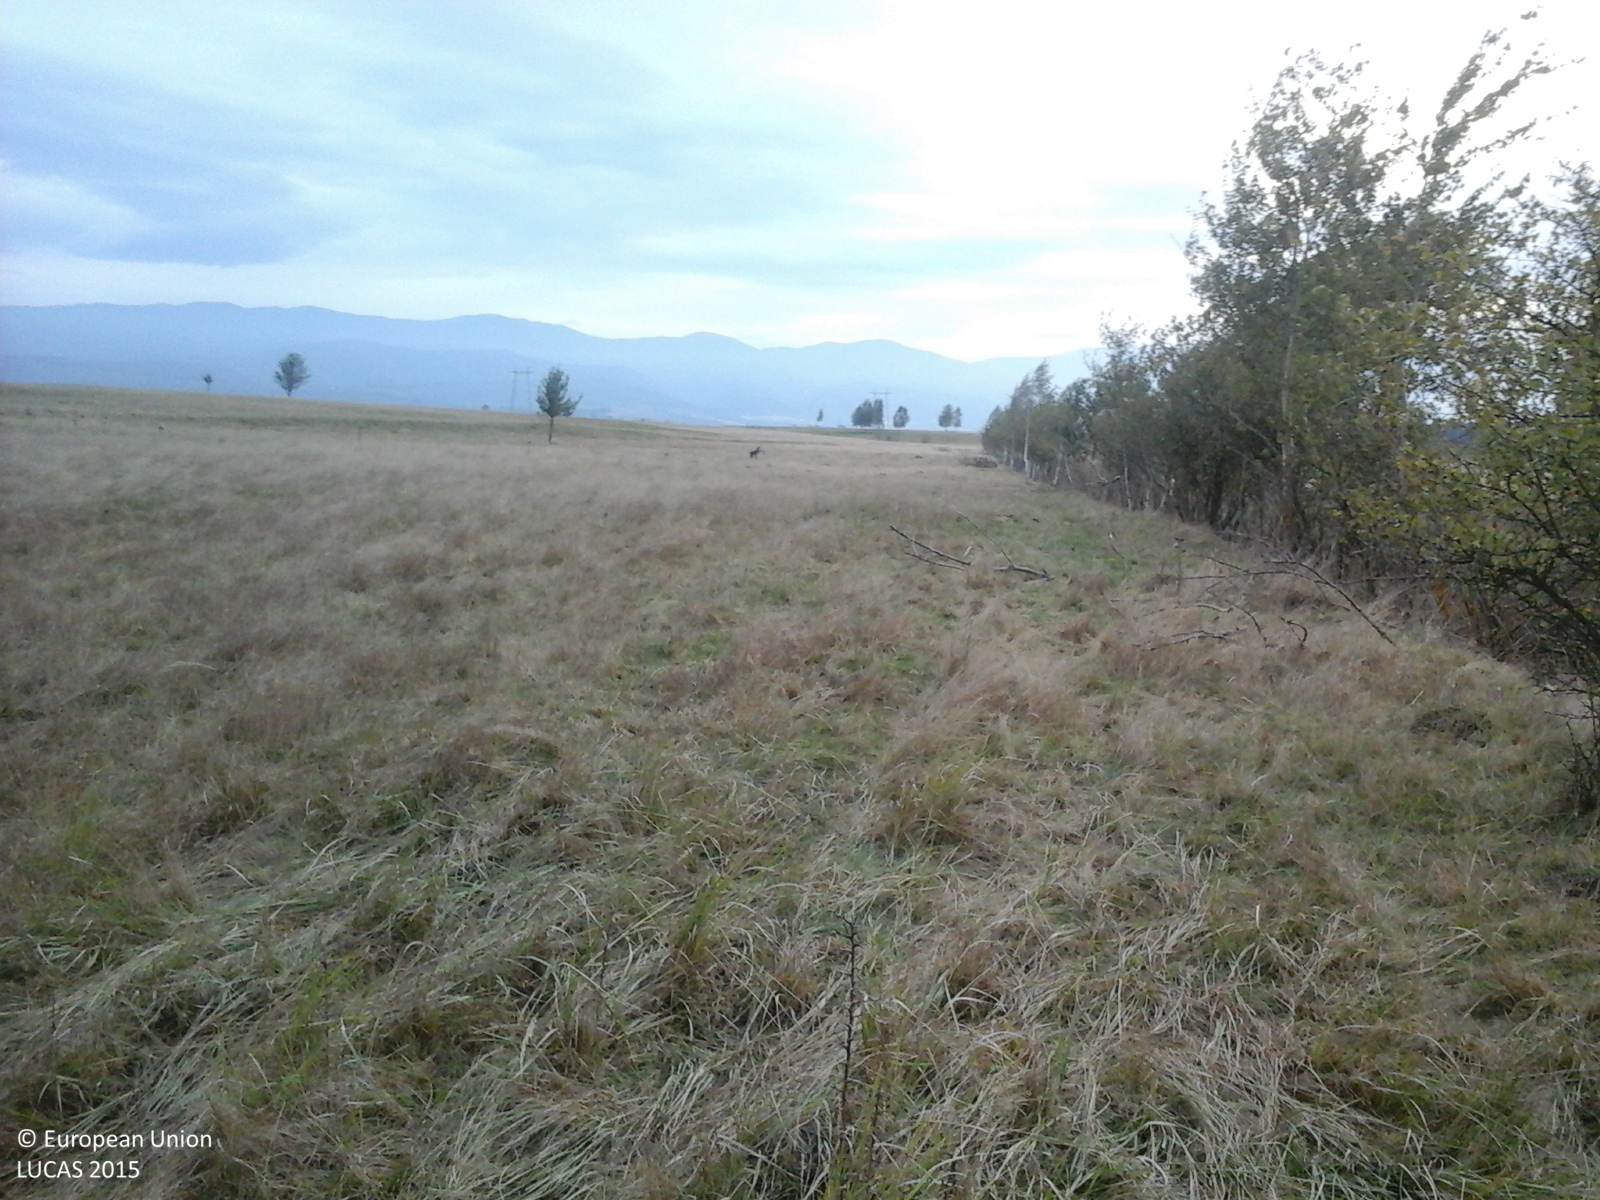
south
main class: Grassland
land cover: Grassland with sparse tree/shrub cover
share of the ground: > 75 %
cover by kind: herbaceous plants 85 %, shrubs 10 %, broadleaved forest trees 5 %
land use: Fallow land
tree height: < 5 m
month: October
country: RO
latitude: 45.7799
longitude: 25.1300
